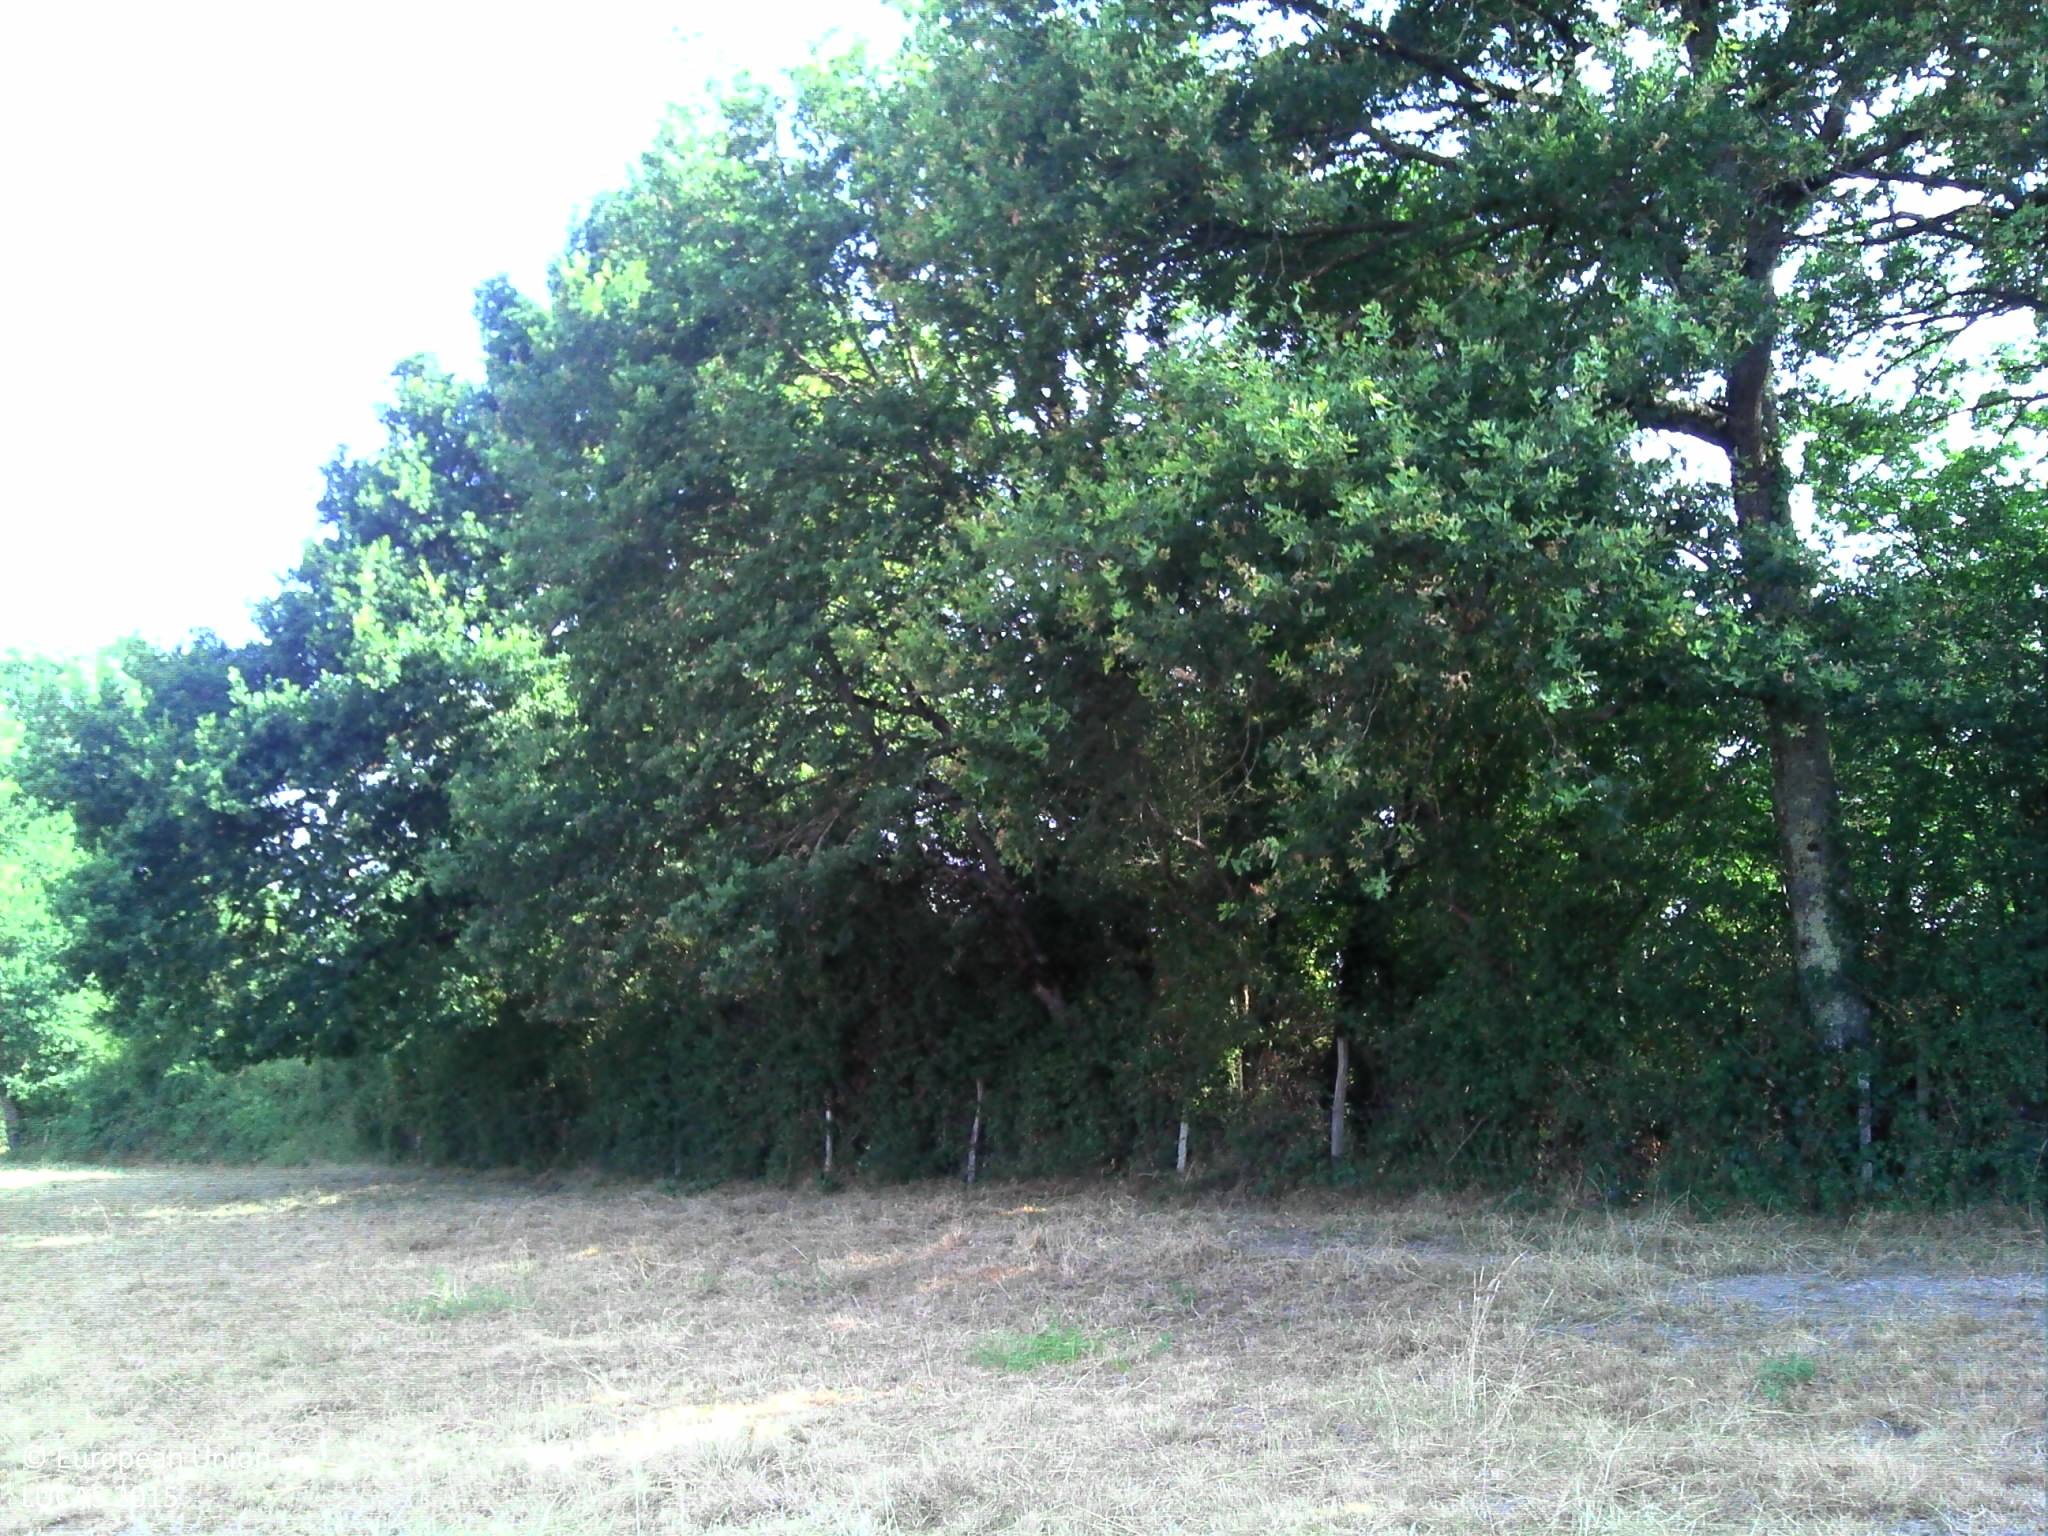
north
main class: Grassland
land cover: Grassland without tree/shrub cover
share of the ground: > 75 %
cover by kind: herbaceous plants 100 %
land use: Agriculture (excluding fallow land and kitchen gardens)
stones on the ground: < 10 %
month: July
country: FR
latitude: 46.7718
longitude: 2.9902
